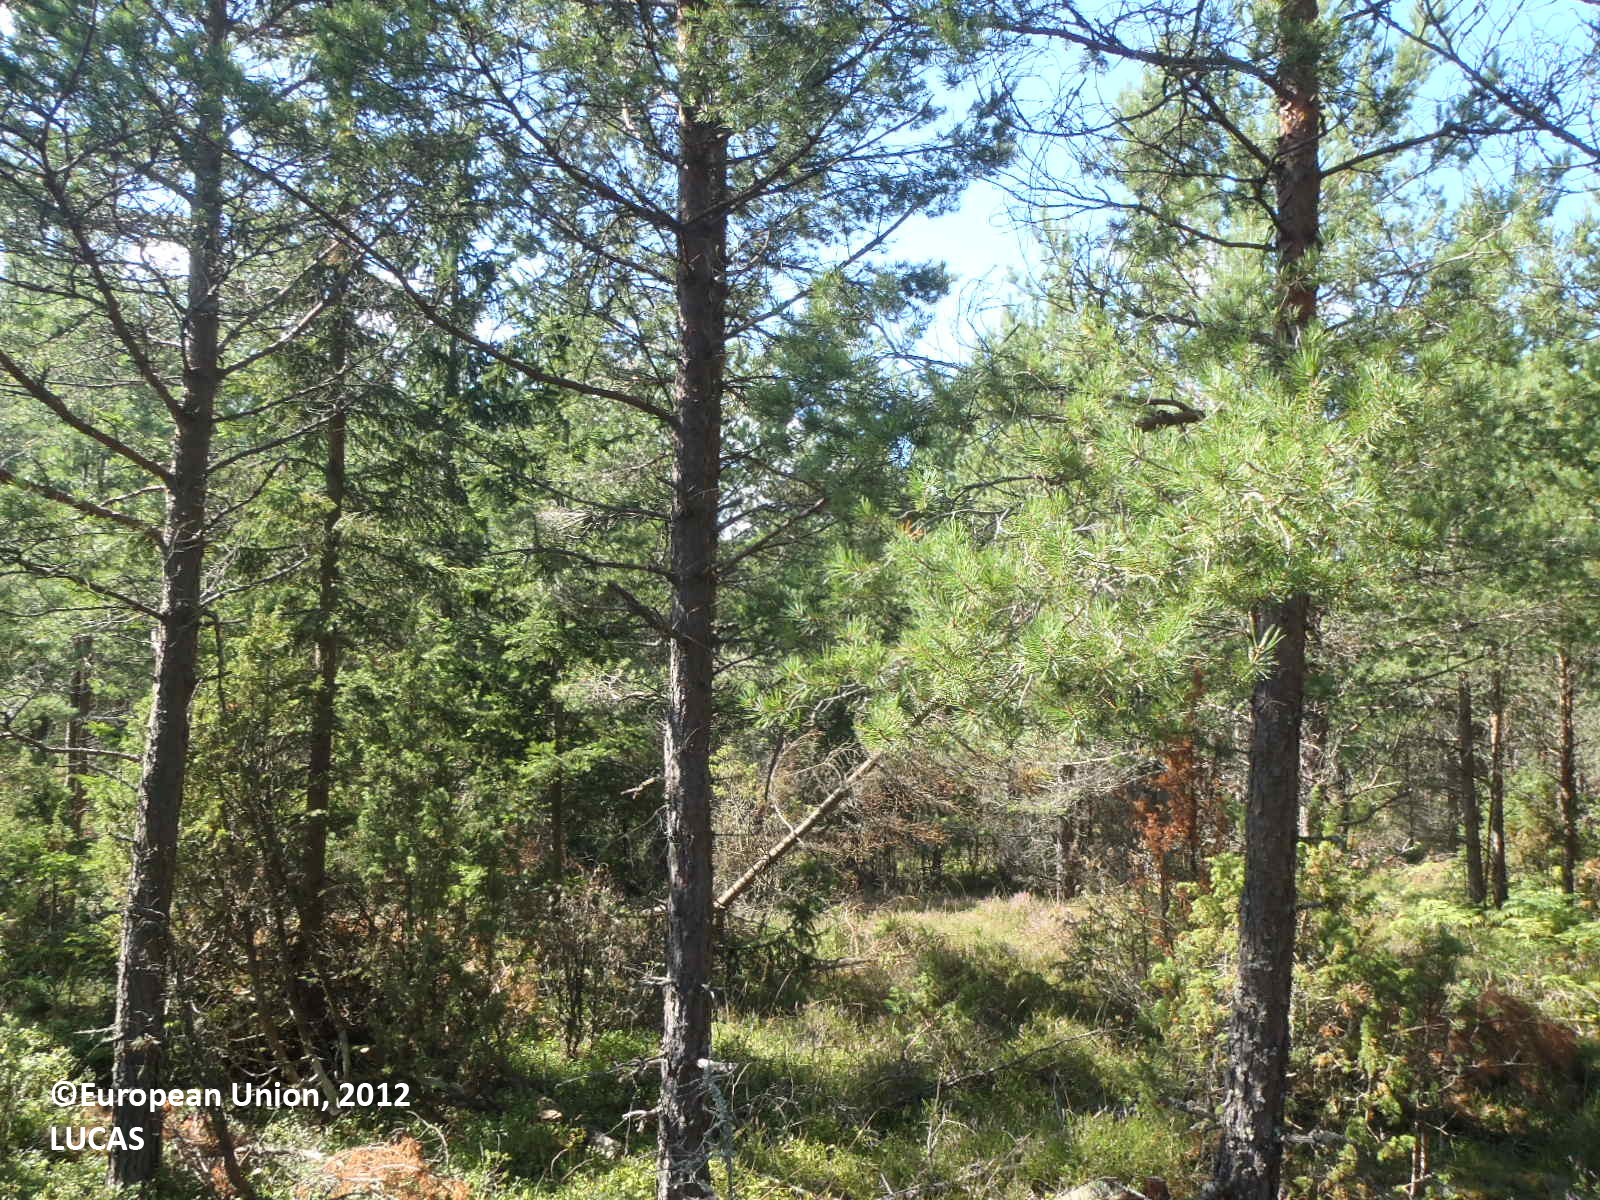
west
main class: Woodland
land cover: Pine dominated coniferous woodland
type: hemiboreal forest and nemoral coniferous forest and mixed broadleaved-coniferous forest
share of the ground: > 75 %
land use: Forestry
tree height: > 5 m
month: August
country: FI
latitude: 60.1741
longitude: 19.9382
